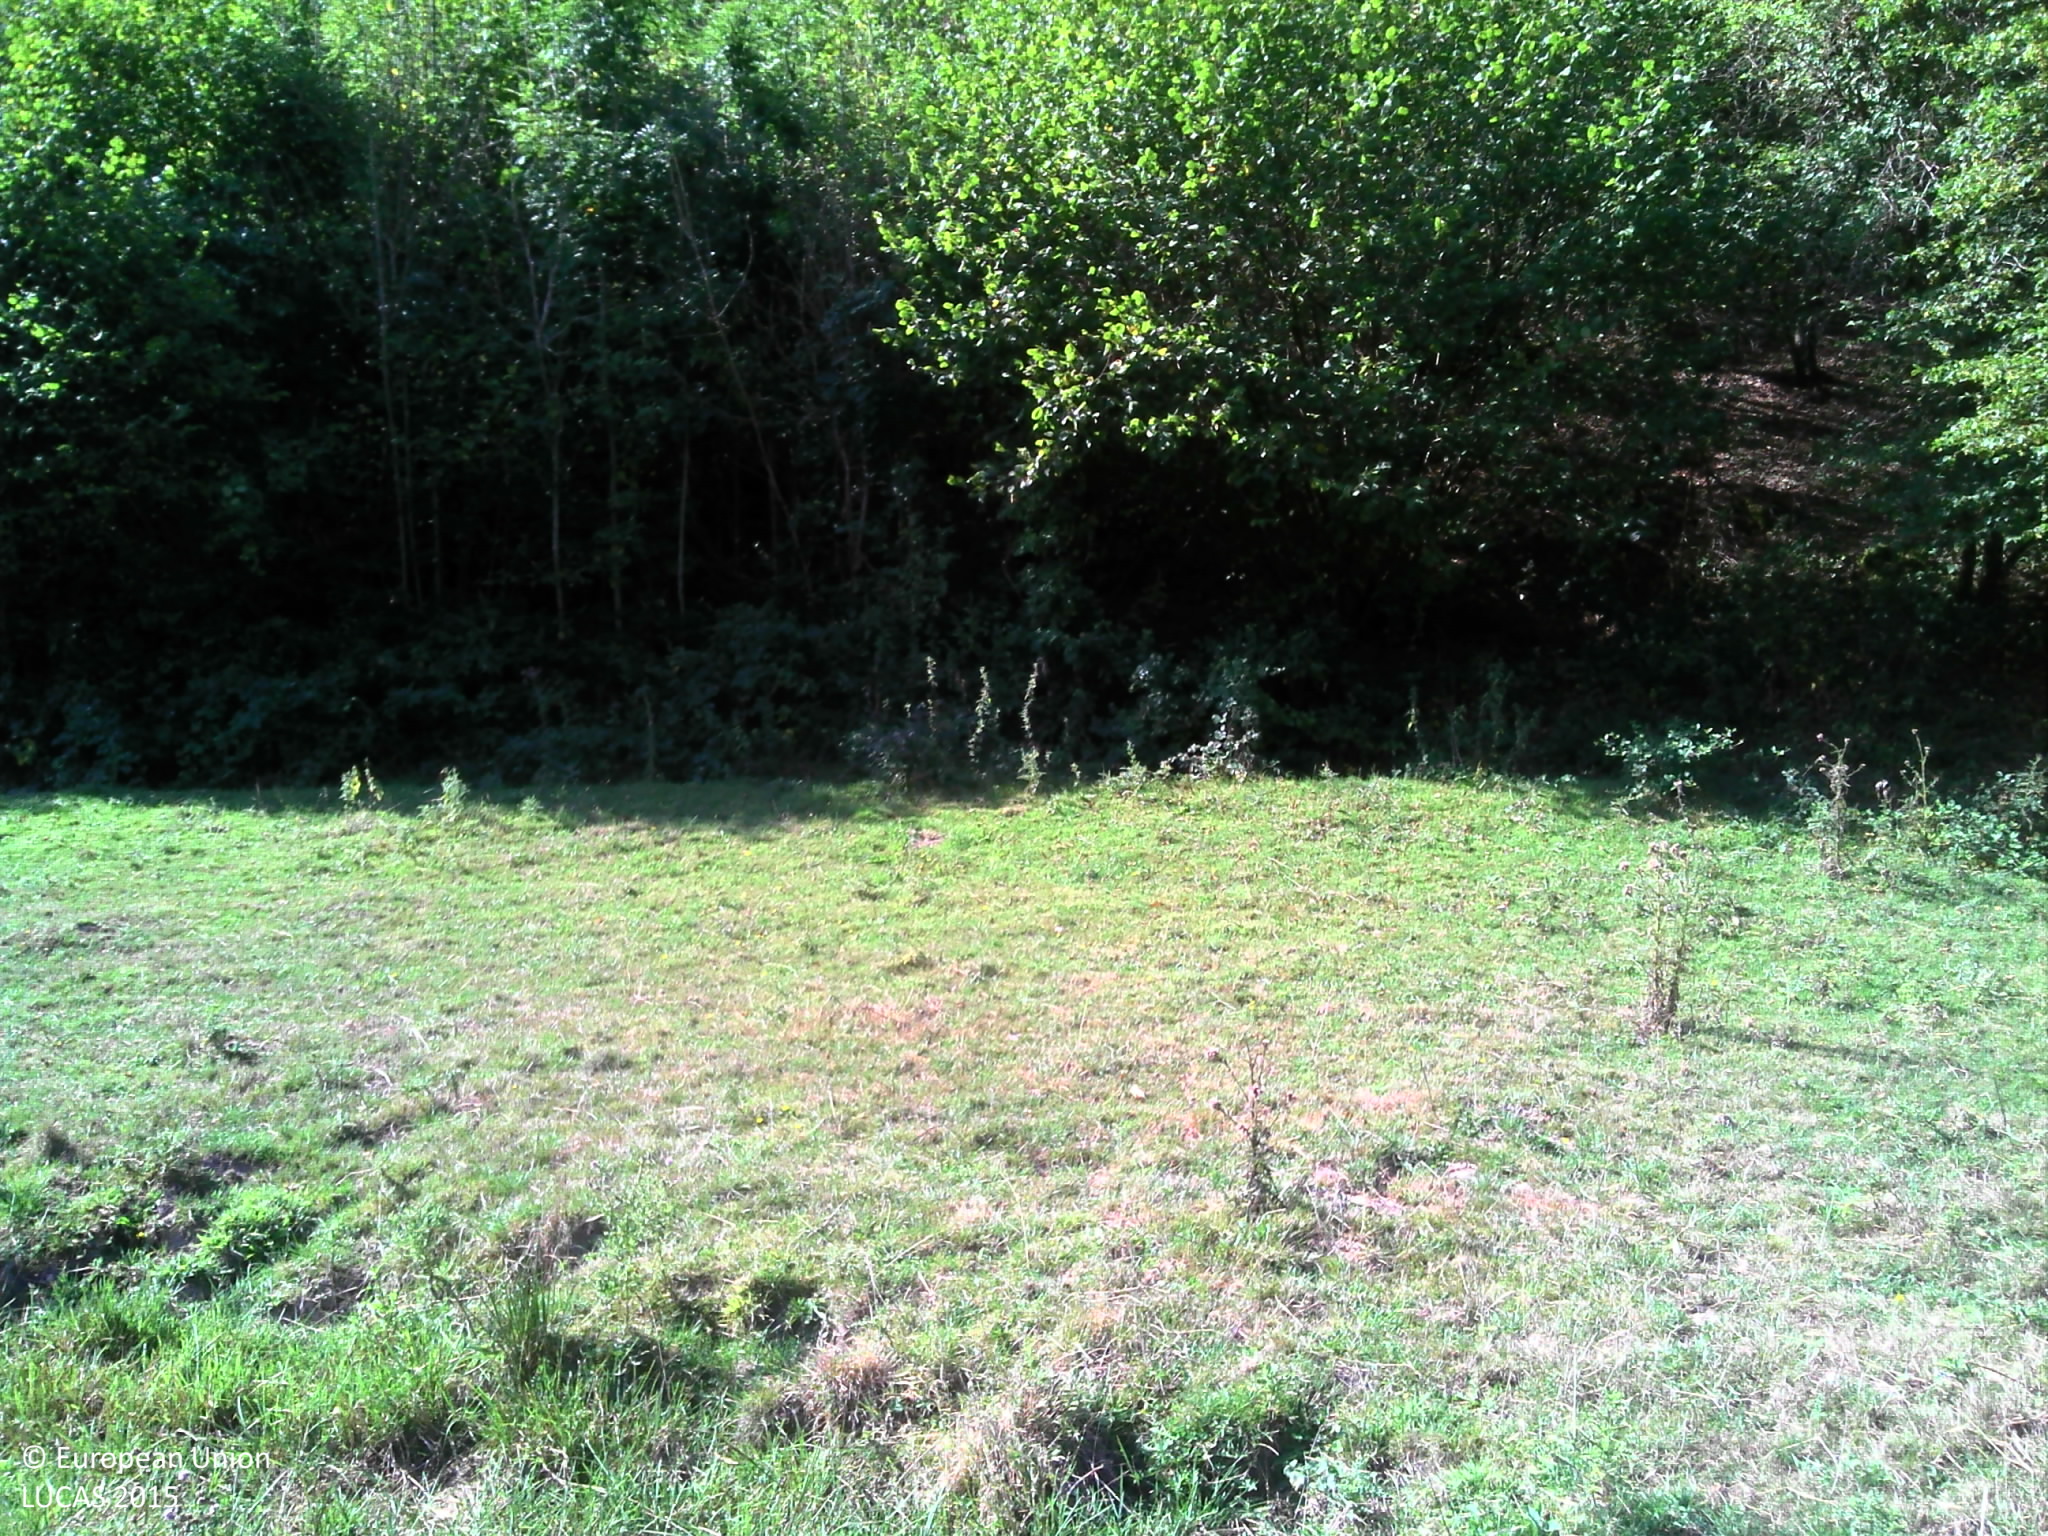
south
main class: Grassland
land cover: Grassland without tree/shrub cover
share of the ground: > 75 %
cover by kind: herbaceous plants 100 %
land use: Agriculture (excluding fallow land and kitchen gardens)
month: August
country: FR
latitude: 46.8171
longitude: 4.3776
